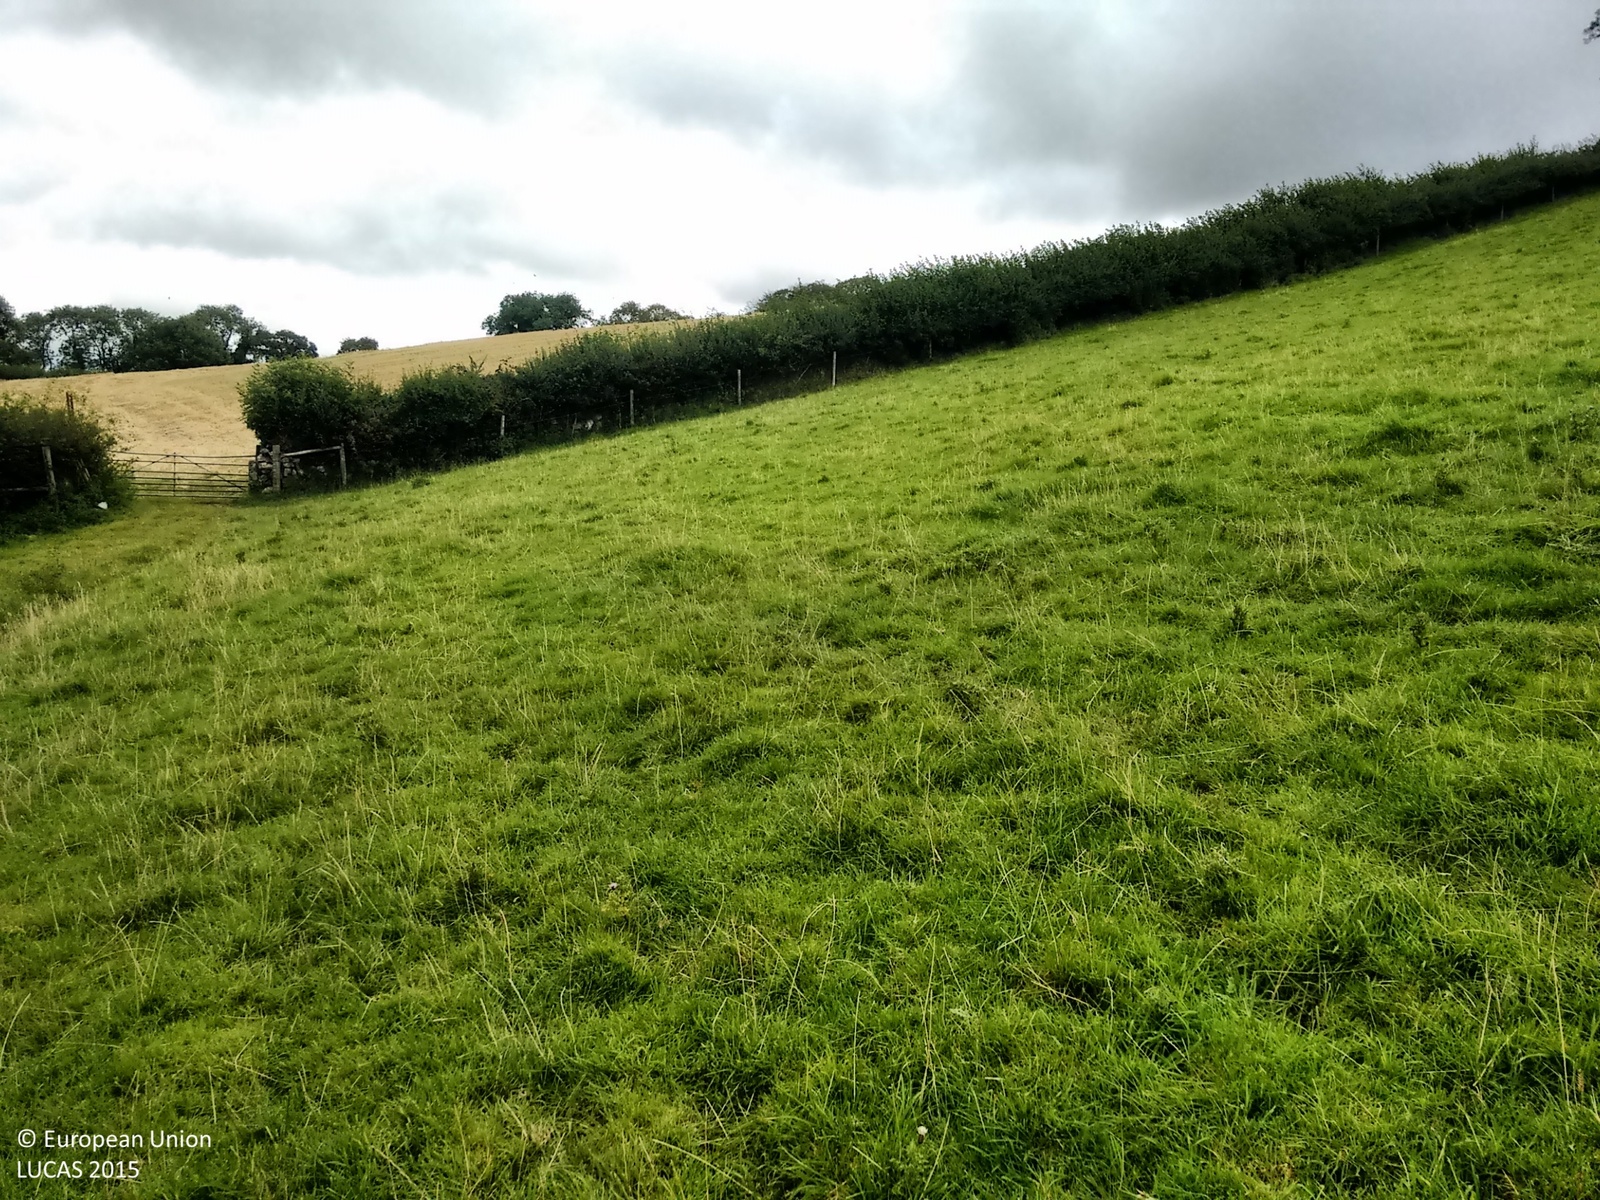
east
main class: Grassland
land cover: Grassland without tree/shrub cover
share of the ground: > 75 %
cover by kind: herbaceous plants 100 %
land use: Agriculture (excluding fallow land and kitchen gardens)
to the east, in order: Grassland without tree/shrub cover; Fences; Managed hedges; Dry stone walls; Barley; Fences; Broadleaved woodland
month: September
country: GB
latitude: 50.6661
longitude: -4.1460
